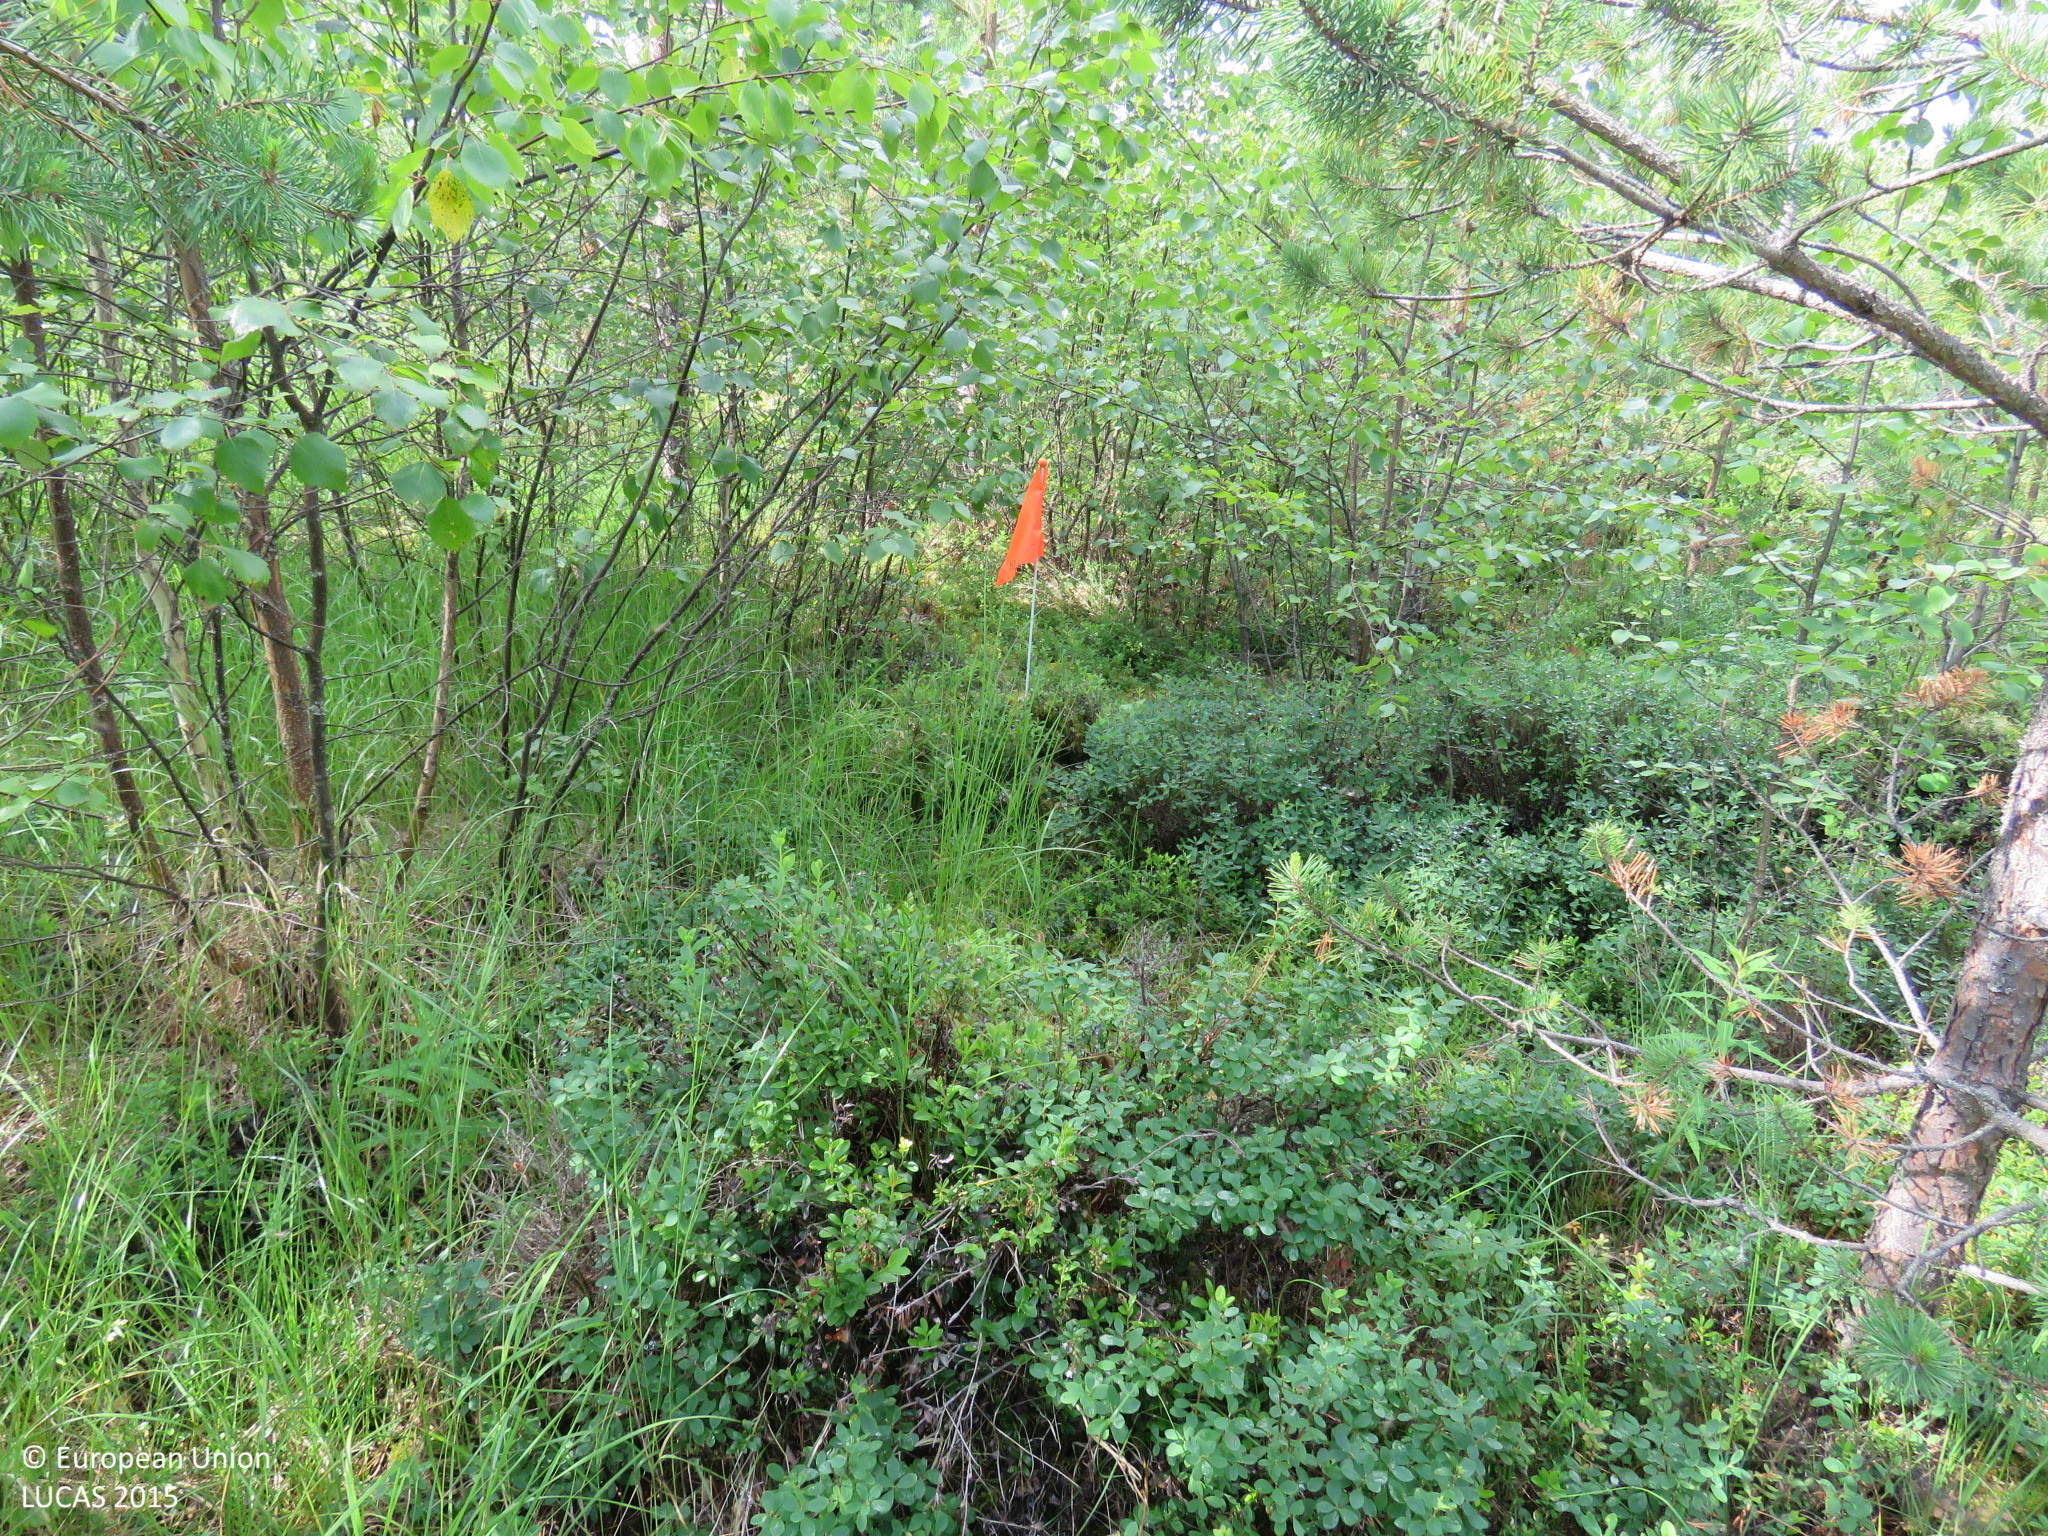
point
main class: Woodland
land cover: Pine dominated mixed woodland
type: boreal forest
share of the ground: > 75 %
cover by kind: broadleaved forest trees 50 %, coniferous forest trees 45 %, shrubs 5 %
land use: Forestry
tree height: < 5 m
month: July
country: FI
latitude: 64.6384
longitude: 26.4964
